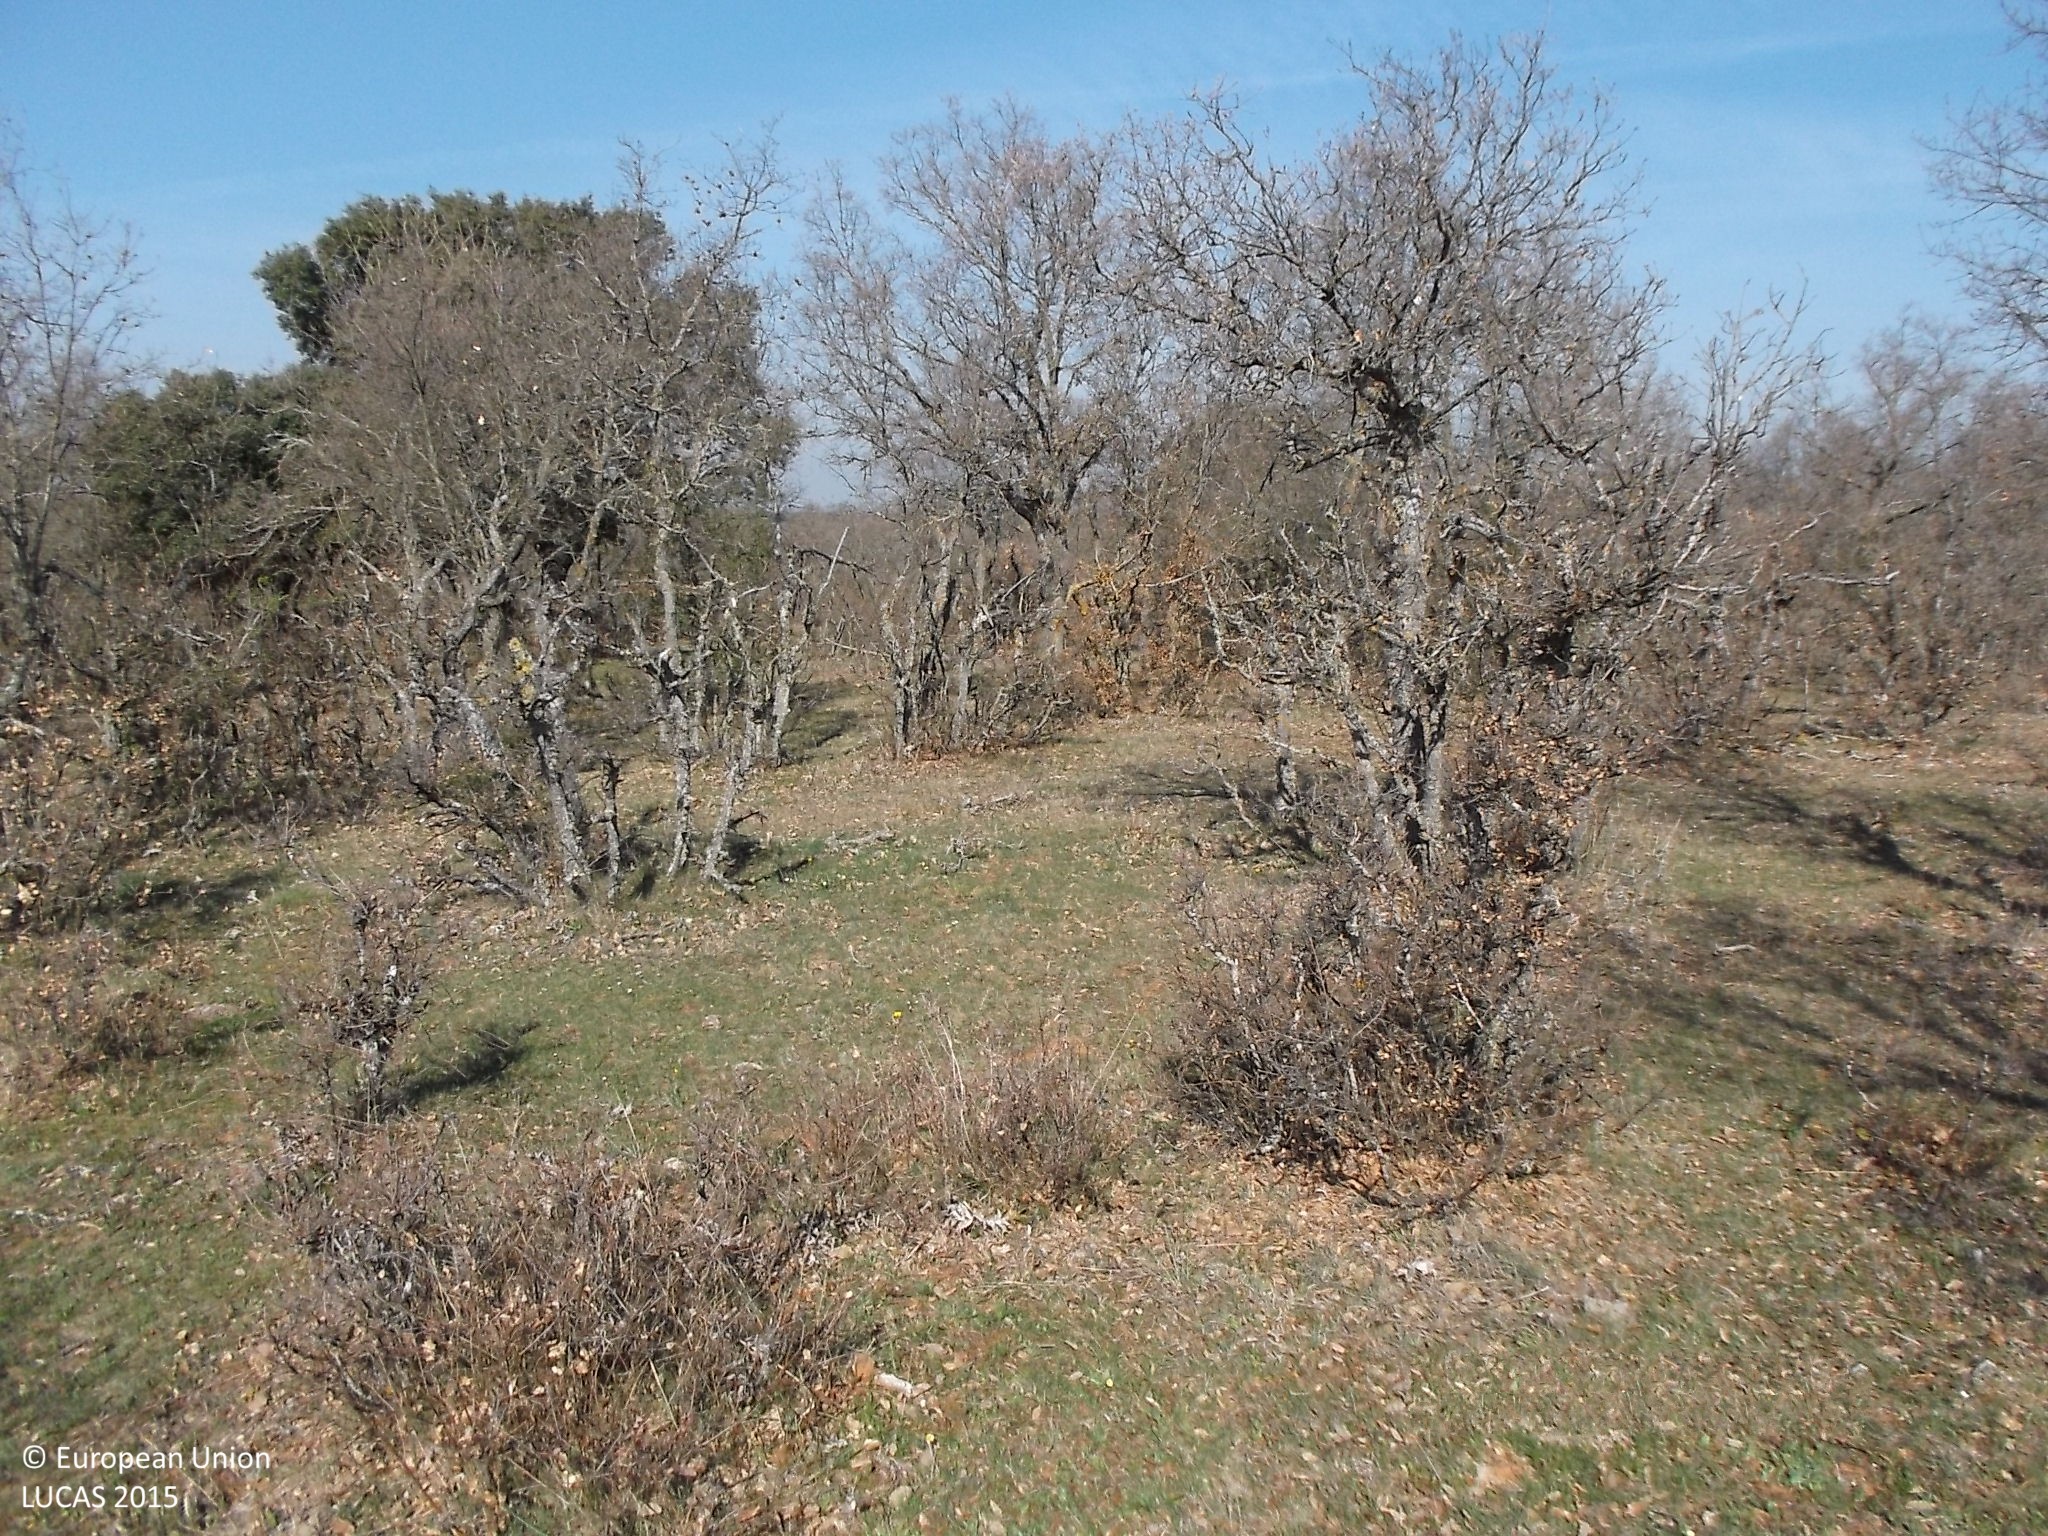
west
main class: Woodland
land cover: Broadleaved woodland
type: broadleaved evergreen forest
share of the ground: 25 - 50 %
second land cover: Grassland without tree/shrub cover
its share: 50 - 75 %
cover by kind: broadleaved forest trees 50 %, herbaceous plants 50 %
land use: Forestry
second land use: Agriculture (excluding fallow land and kitchen gardens)
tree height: < 5 m
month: April
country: ES
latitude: 40.8782
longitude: -5.8747
